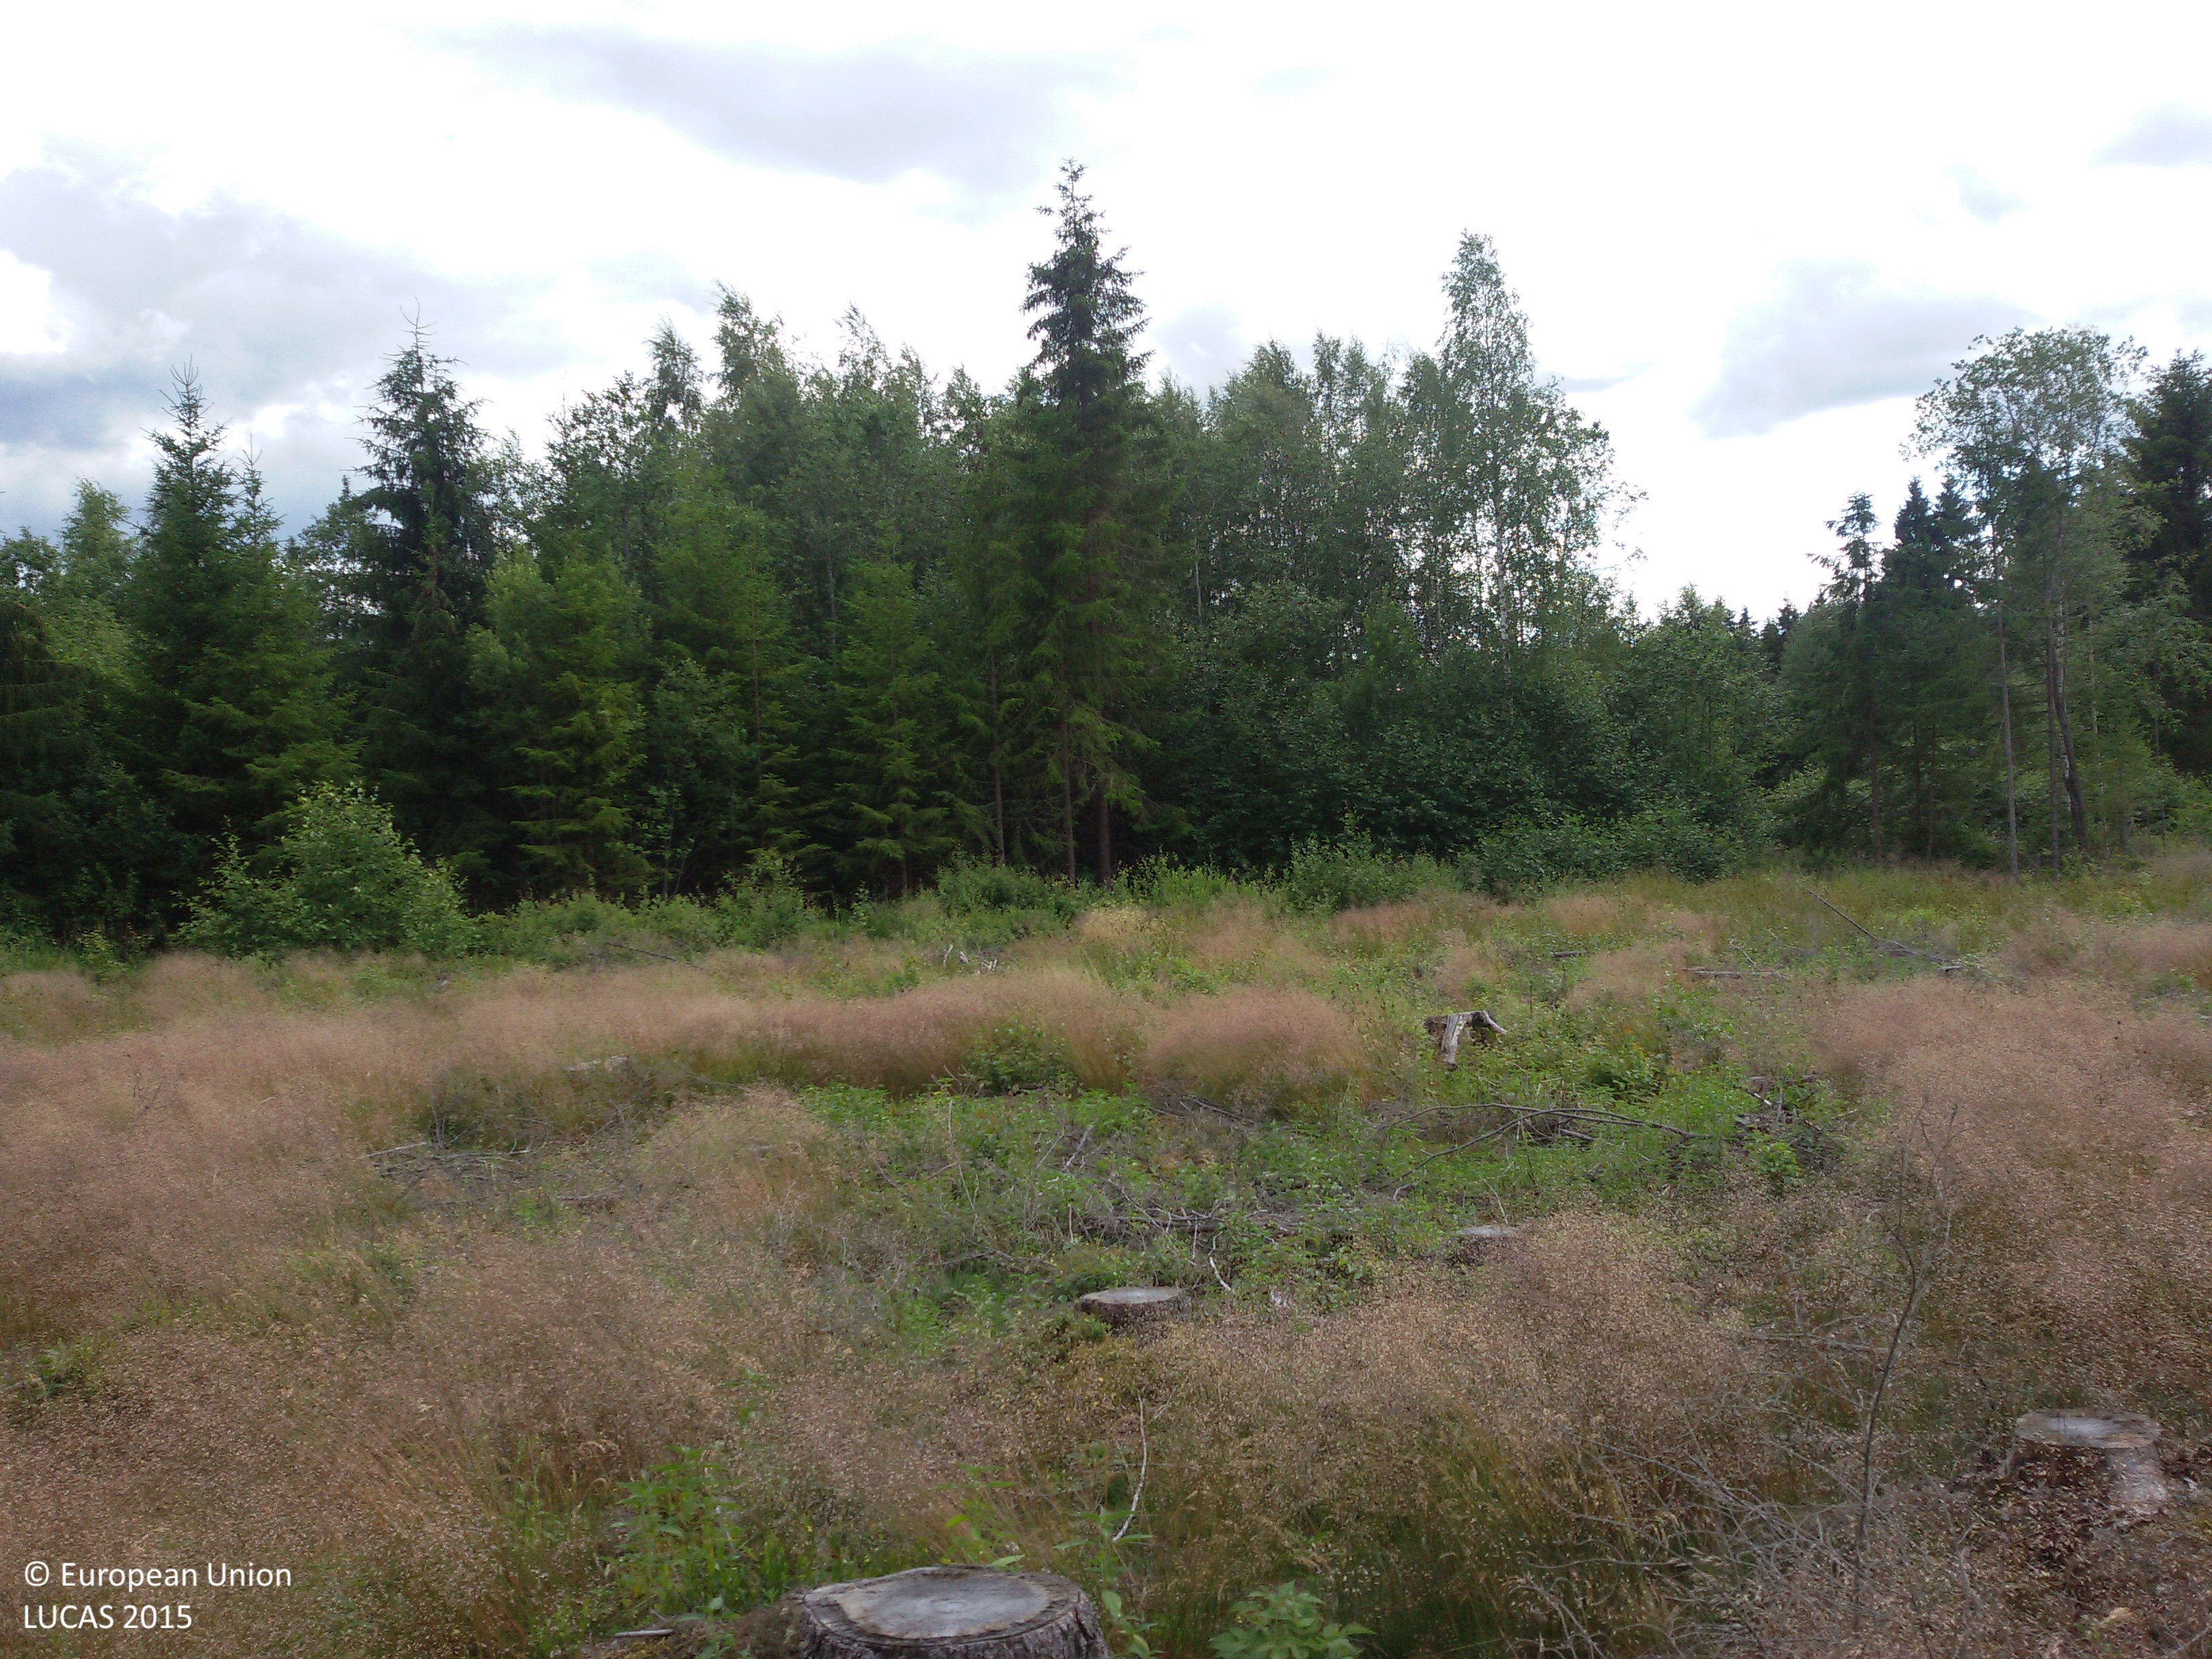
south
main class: Woodland
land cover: Spruce dominated mixed woodland
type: boreal forest
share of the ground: 25 - 50 %
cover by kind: herbaceous plants 50 %, broadleaved forest trees 30 %, coniferous forest trees 20 %
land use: Forestry
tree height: < 5 m
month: July
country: SE
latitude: 60.4389
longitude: 15.3848
